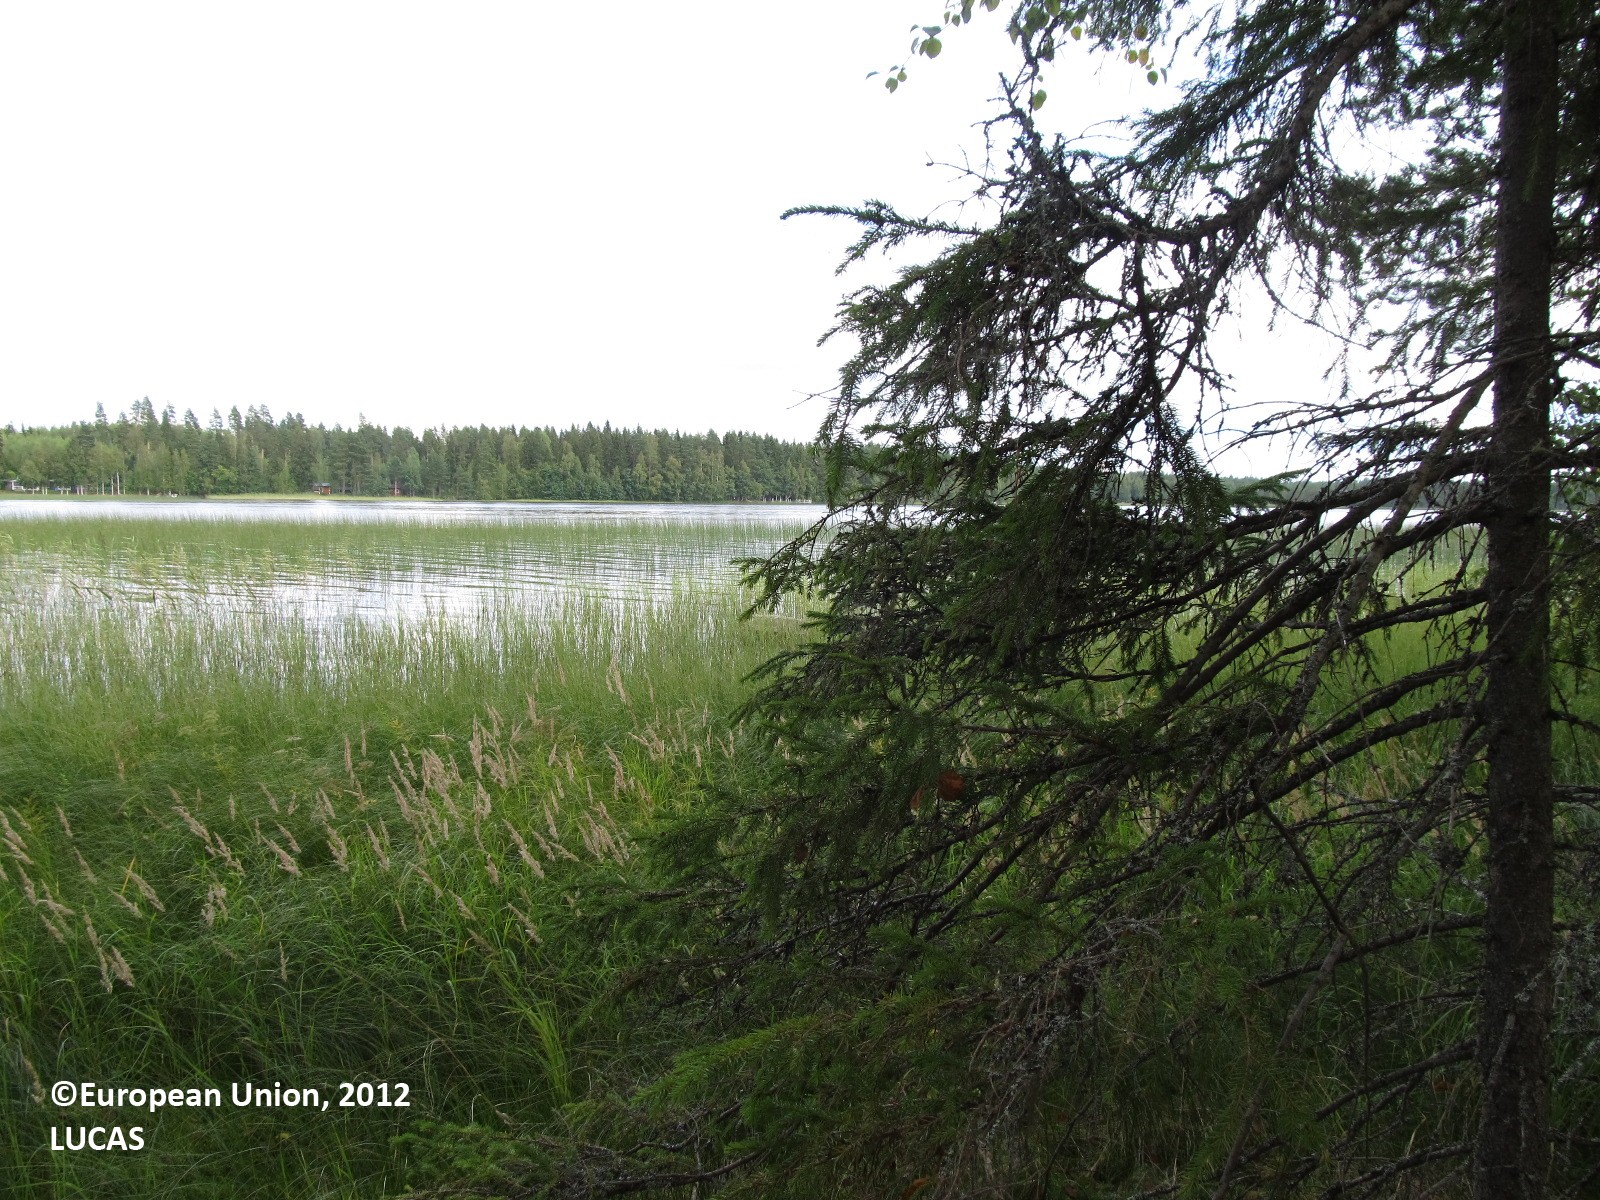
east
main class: Woodland
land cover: Spruce dominated mixed woodland
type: boreal forest
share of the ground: 50 - 75 %
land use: Forestry
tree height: > 5 m
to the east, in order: Spruce dominated mixed woodland; Inland water bodies
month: August
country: FI
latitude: 61.9847
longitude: 27.4815
